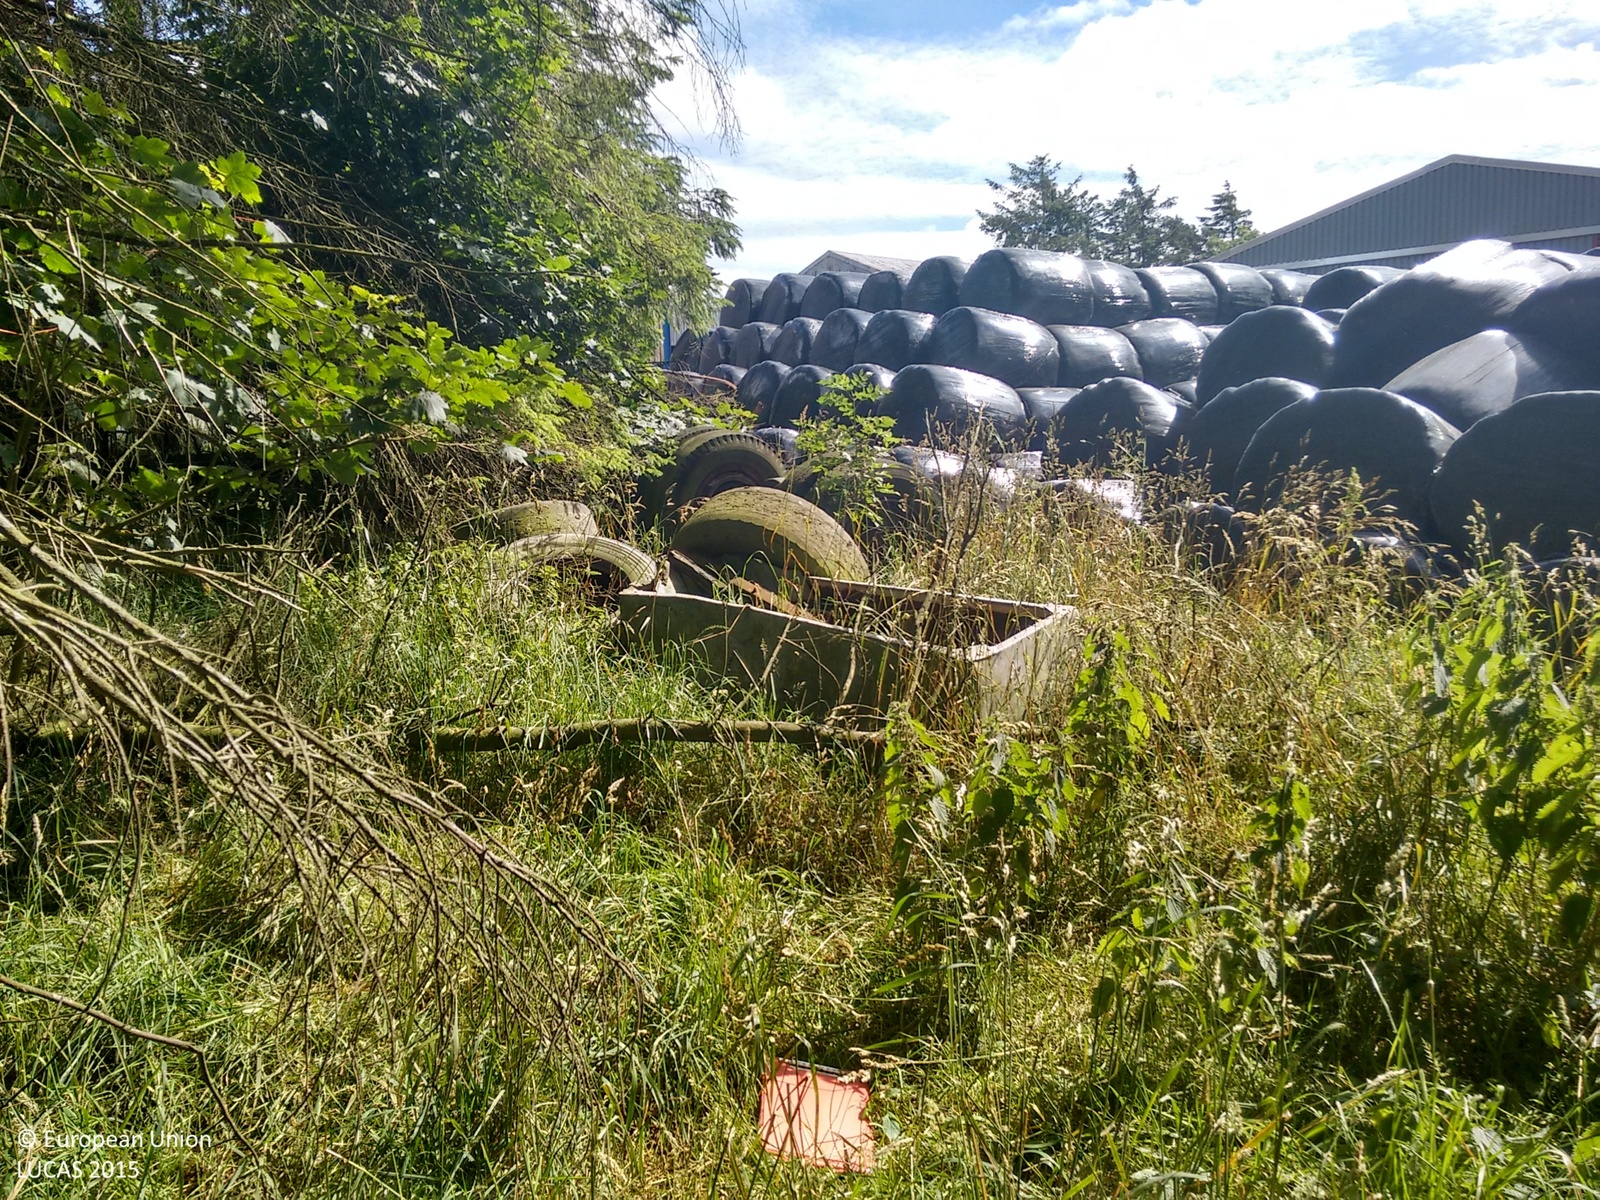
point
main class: Woodland
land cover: Spruce dominated coniferous woodland
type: exotic forest
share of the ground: > 75 %
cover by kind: coniferous forest trees 70 %, herbaceous plants 10 %, broadleaved forest trees 5 %, shrubs 5 %
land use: Agriculture (excluding fallow land and kitchen gardens)
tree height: > 5 m
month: August
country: GB
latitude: 57.5679
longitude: -2.9838
